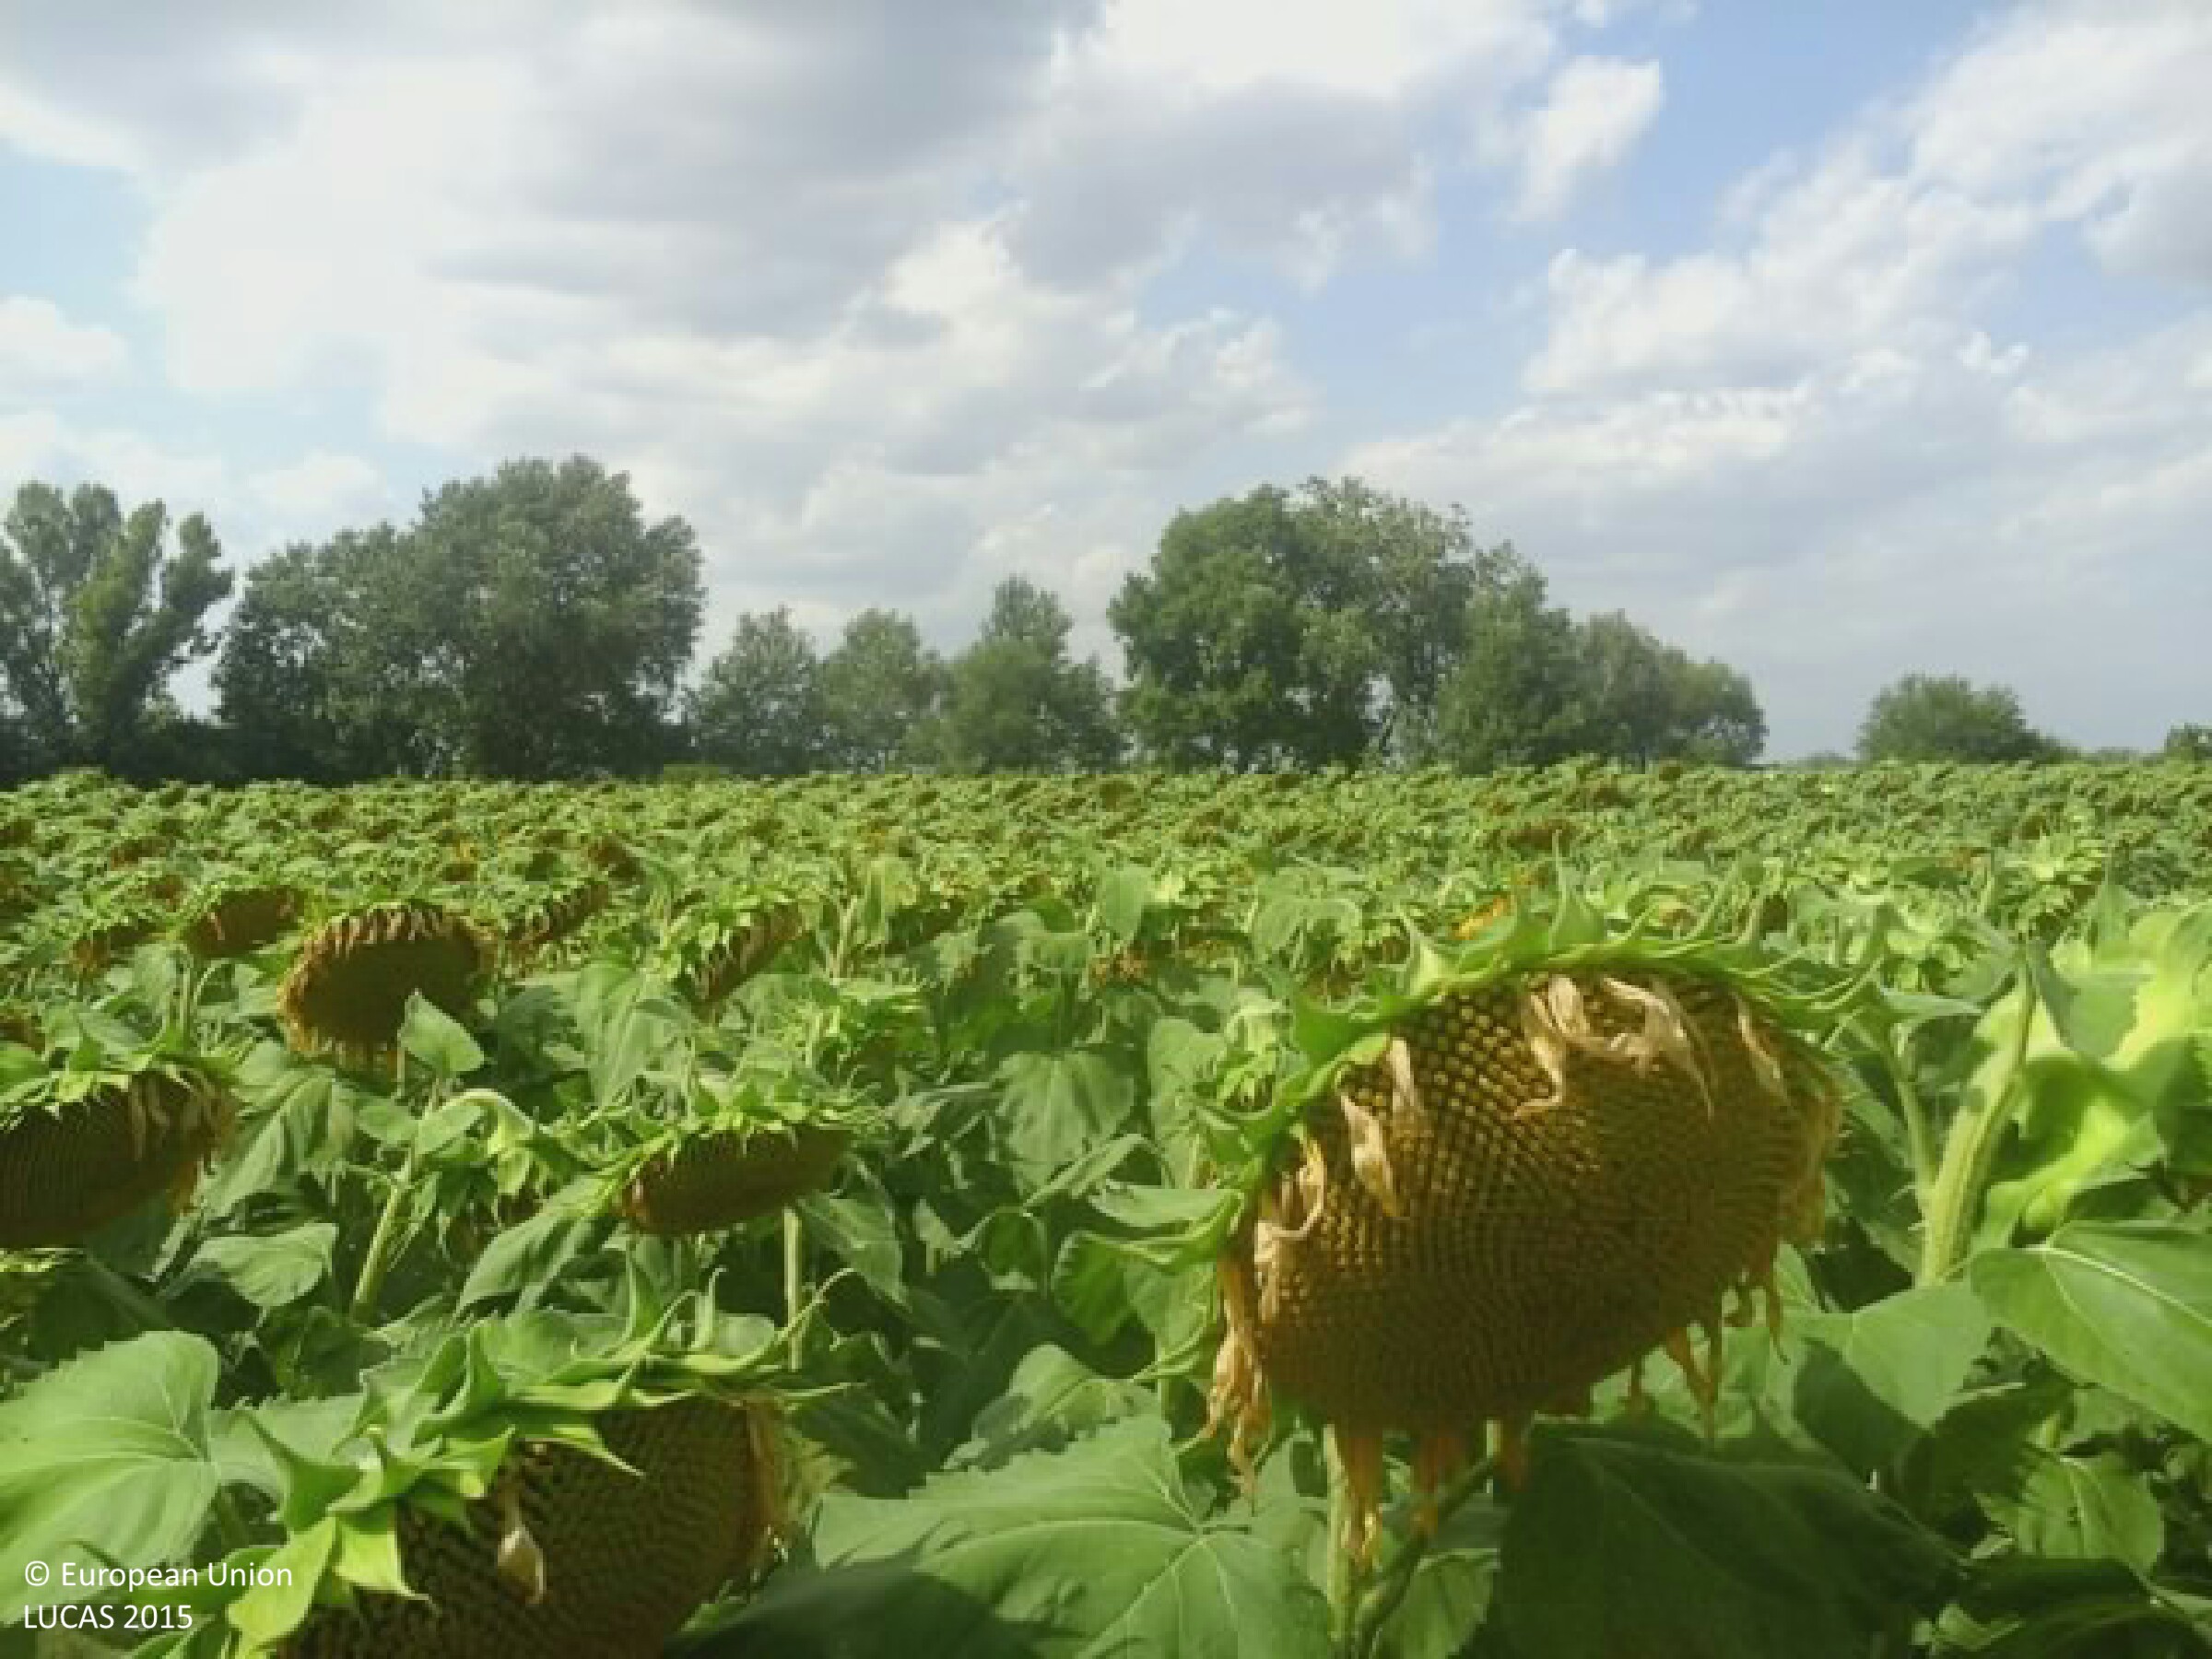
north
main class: Cropland
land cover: Sunflower
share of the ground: > 75 %
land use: Agriculture (excluding fallow land and kitchen gardens)
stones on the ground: < 10 %
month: July
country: HU
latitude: 46.6667
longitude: 18.9145
